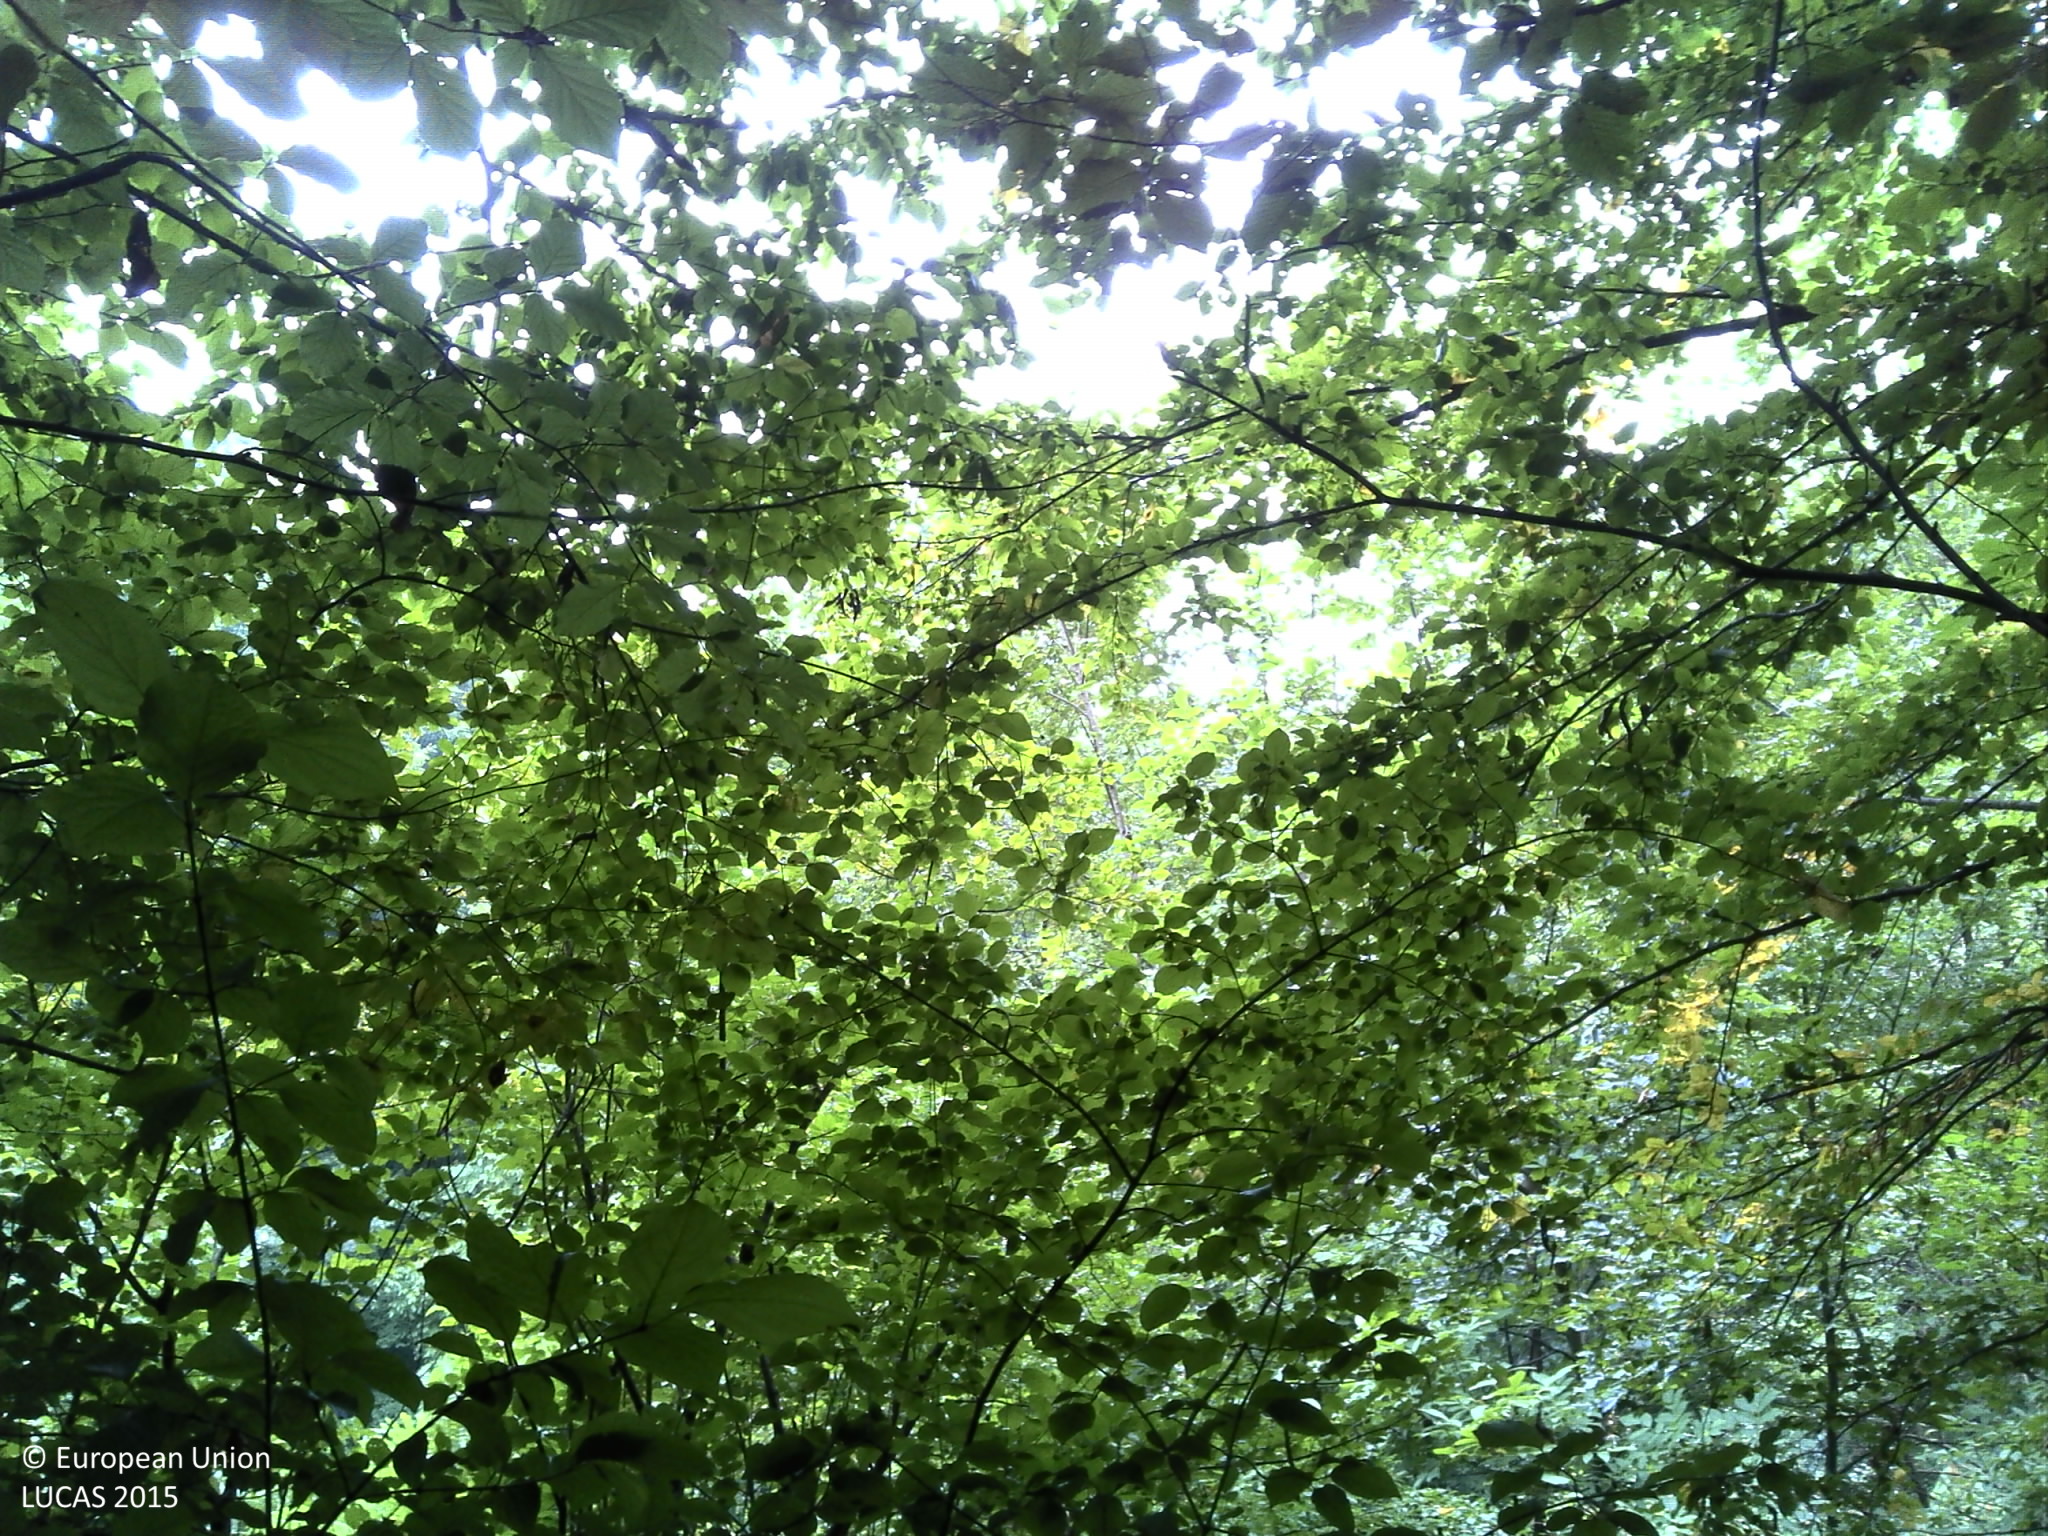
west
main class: Woodland
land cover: Broadleaved woodland
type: beech forest
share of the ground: > 75 %
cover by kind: broadleaved forest trees 100 %
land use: Forestry
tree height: > 5 m
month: August
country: HR
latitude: 45.2439
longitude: 15.6650
